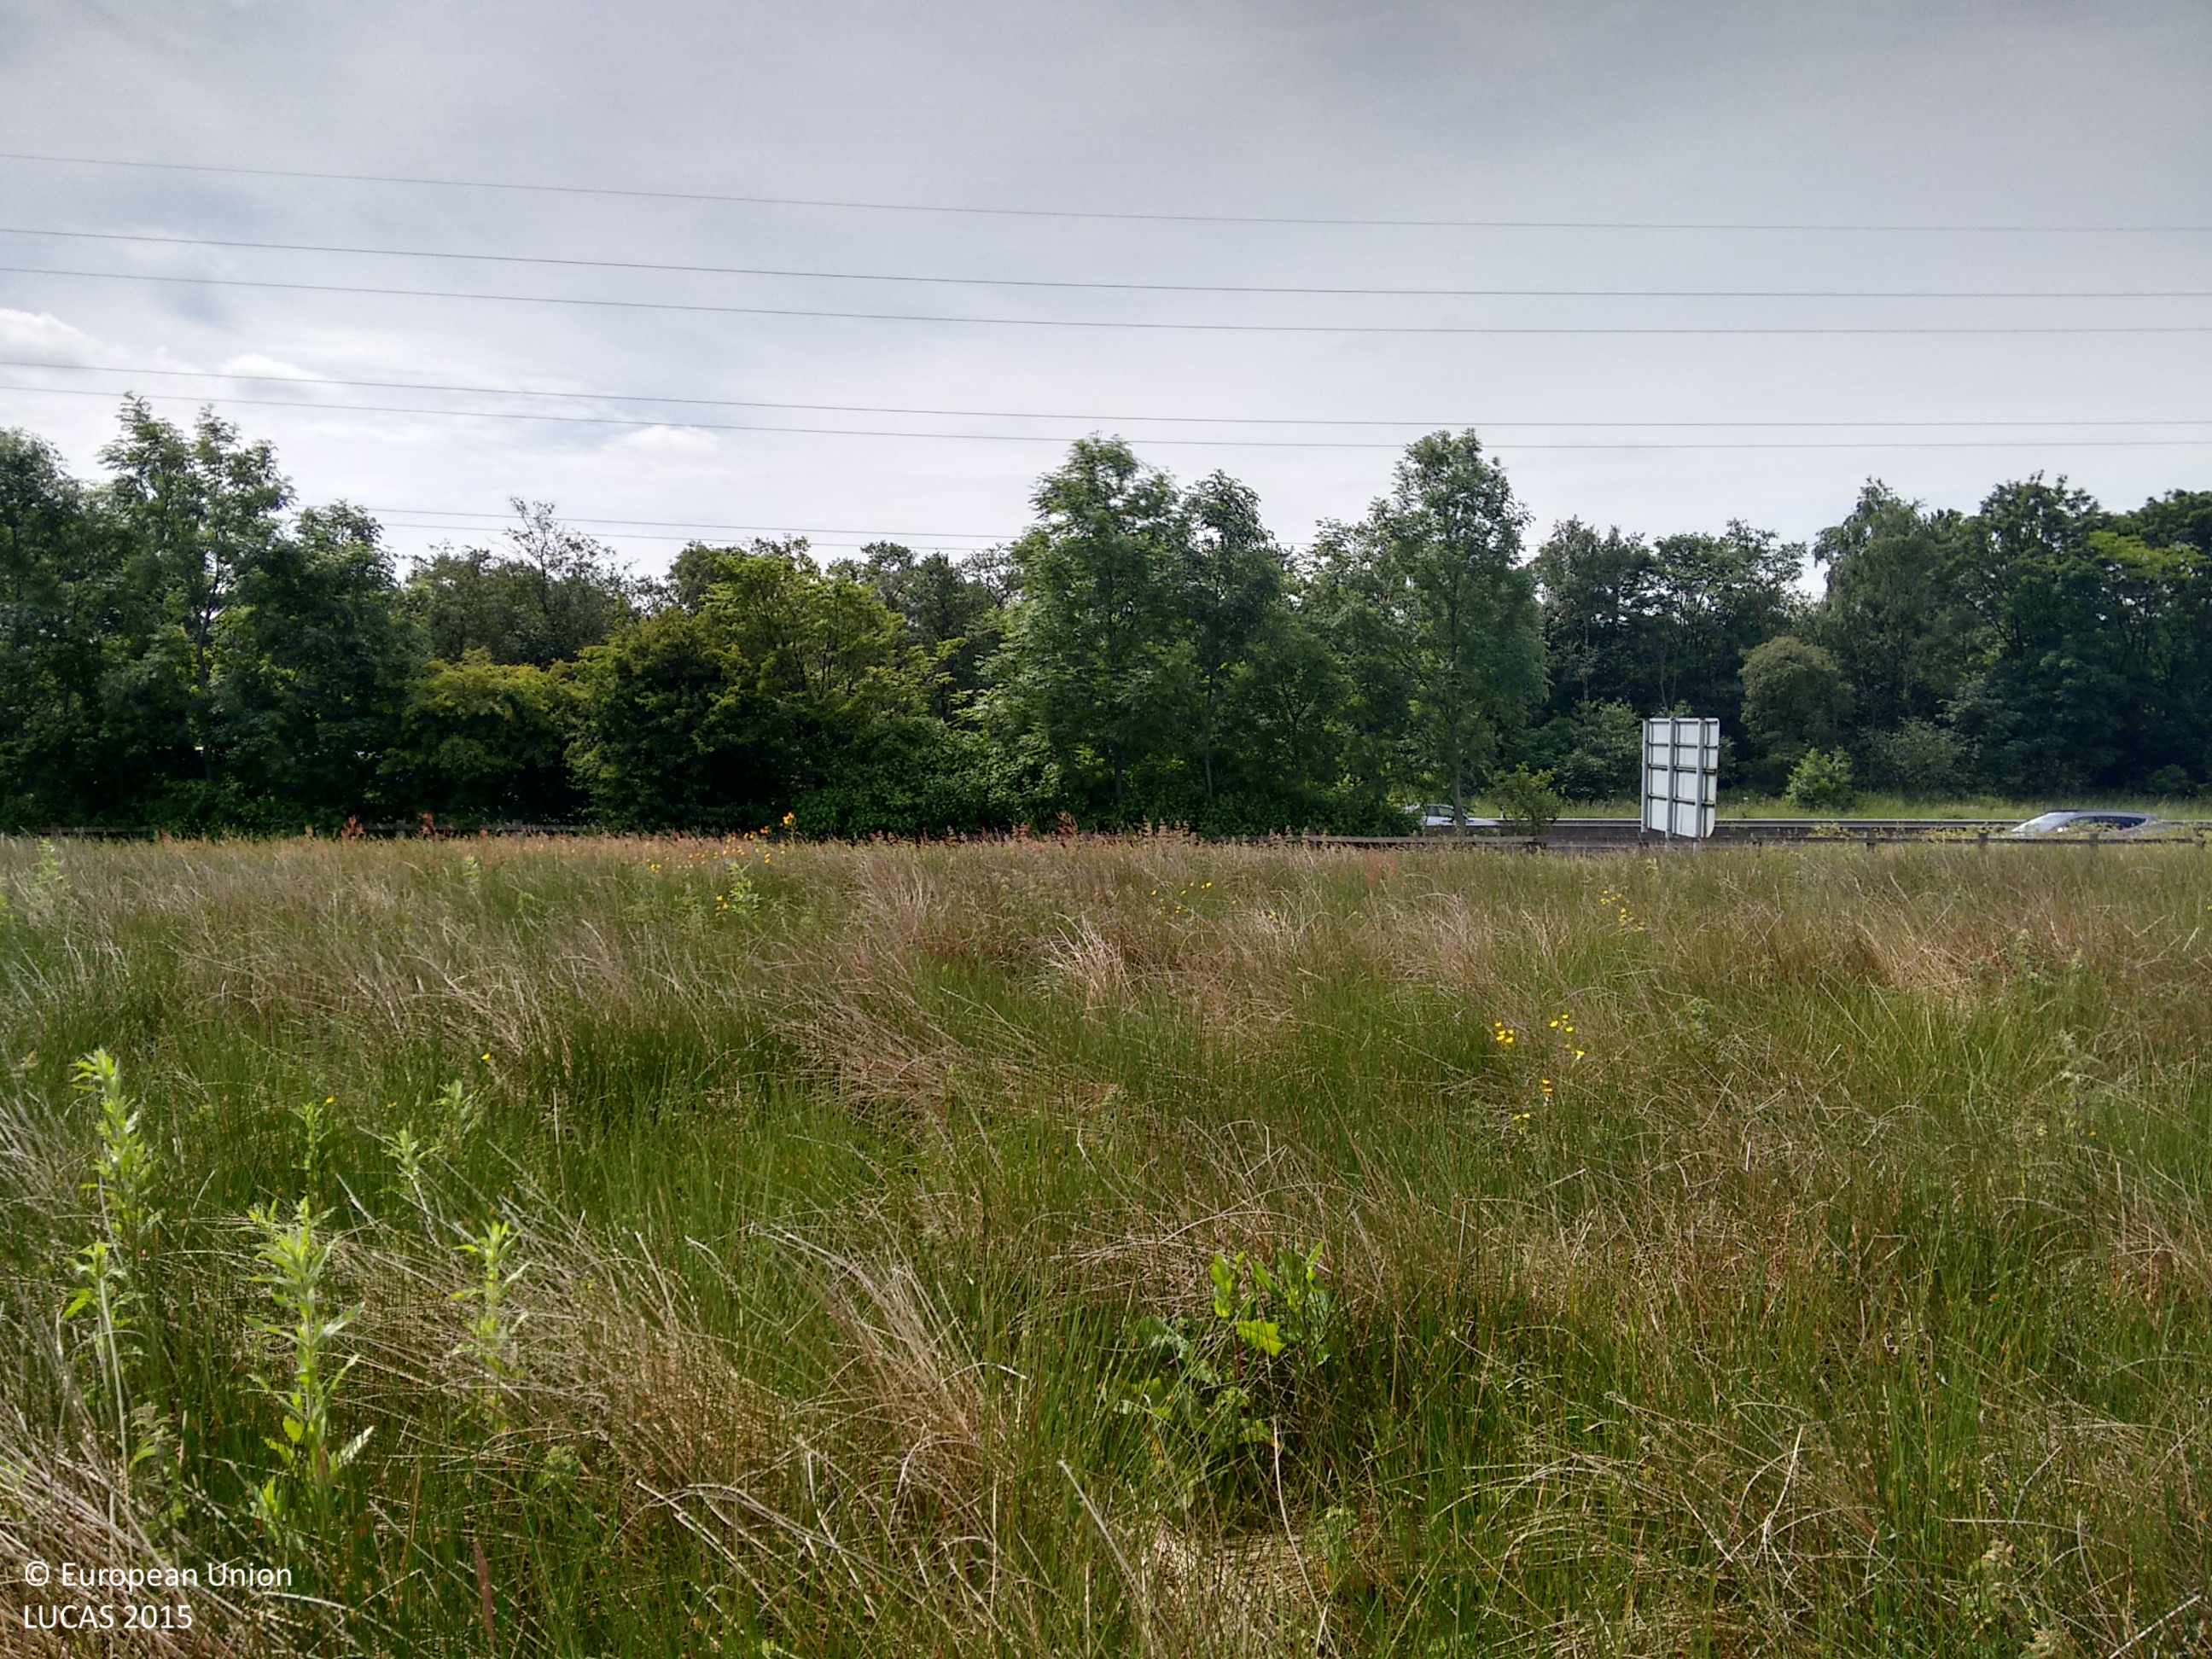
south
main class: Grassland
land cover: Grassland without tree/shrub cover
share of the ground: > 75 %
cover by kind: herbaceous plants 100 %
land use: Semi-natural and natural areas not in use
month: June
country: GB
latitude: 53.5418
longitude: -2.4231
